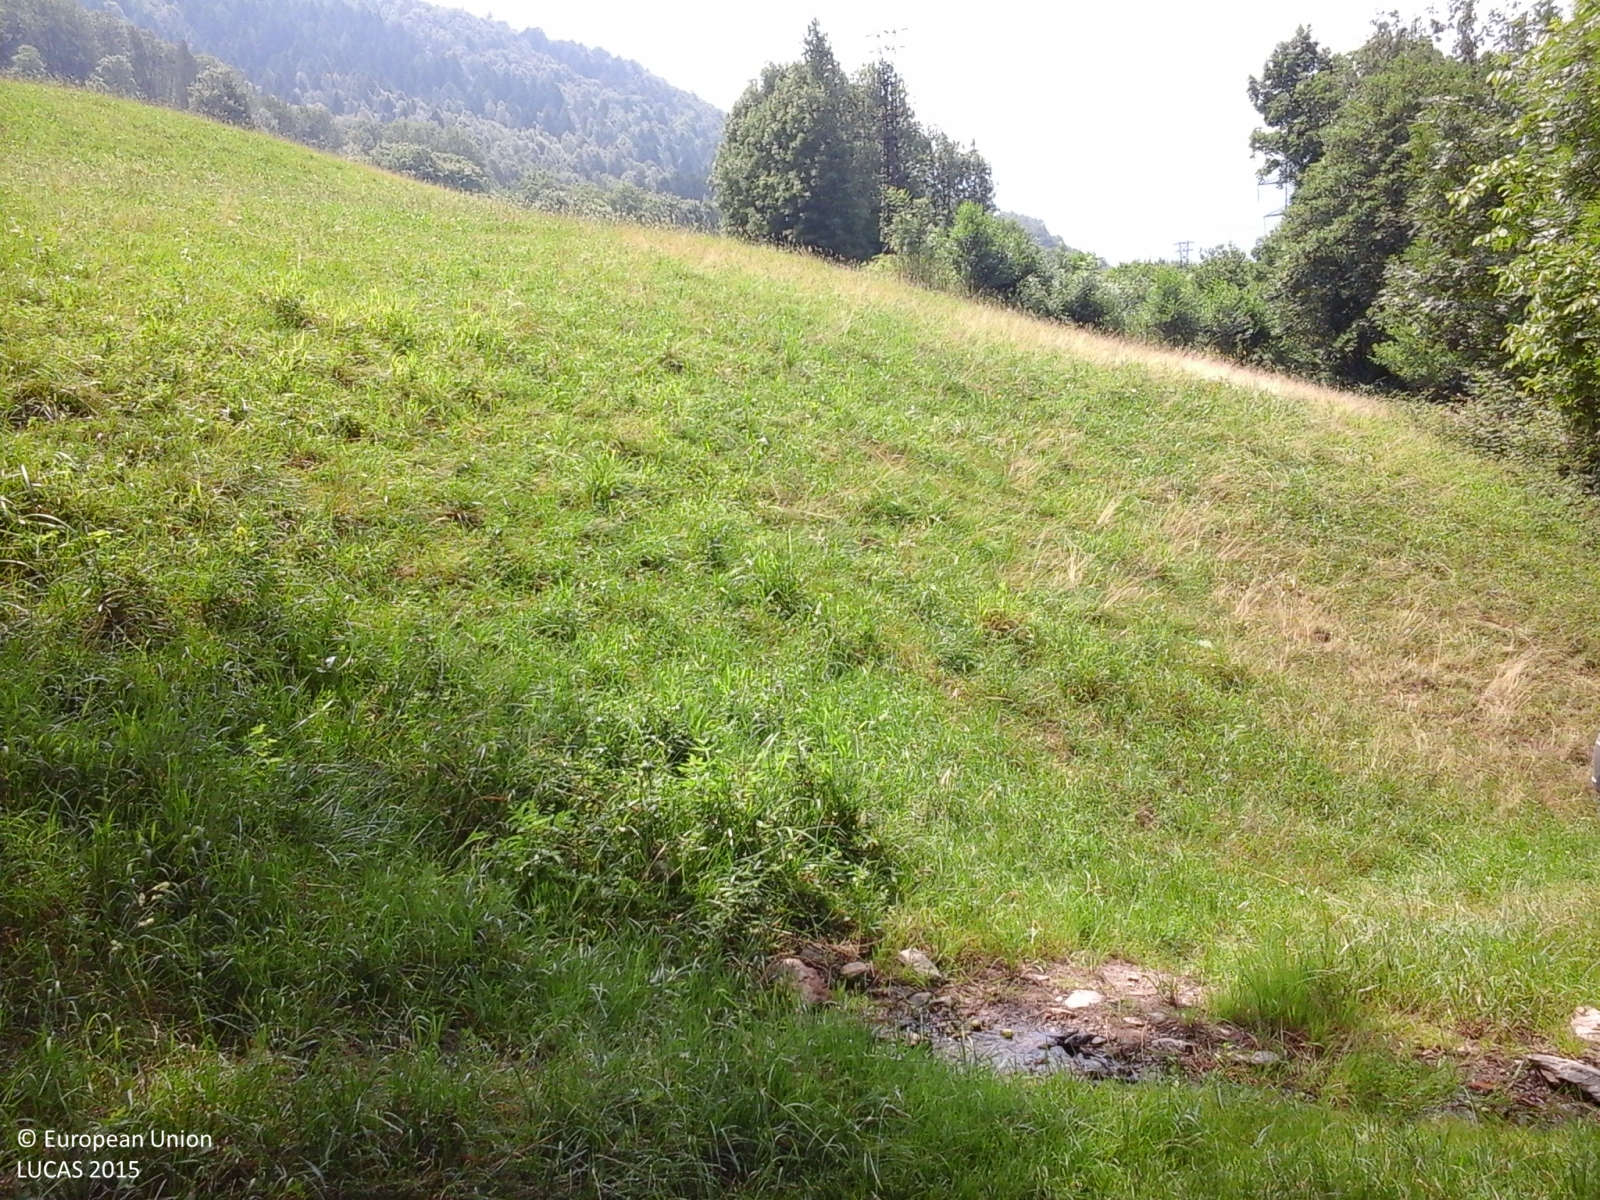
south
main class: Grassland
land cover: Grassland with sparse tree/shrub cover
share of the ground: > 75 %
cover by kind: herbaceous plants 95 %, broadleaved forest trees 5 %
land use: Agriculture (excluding fallow land and kitchen gardens)
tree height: > 5 m
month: July
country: IT
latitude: 46.1165
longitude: 10.3230
